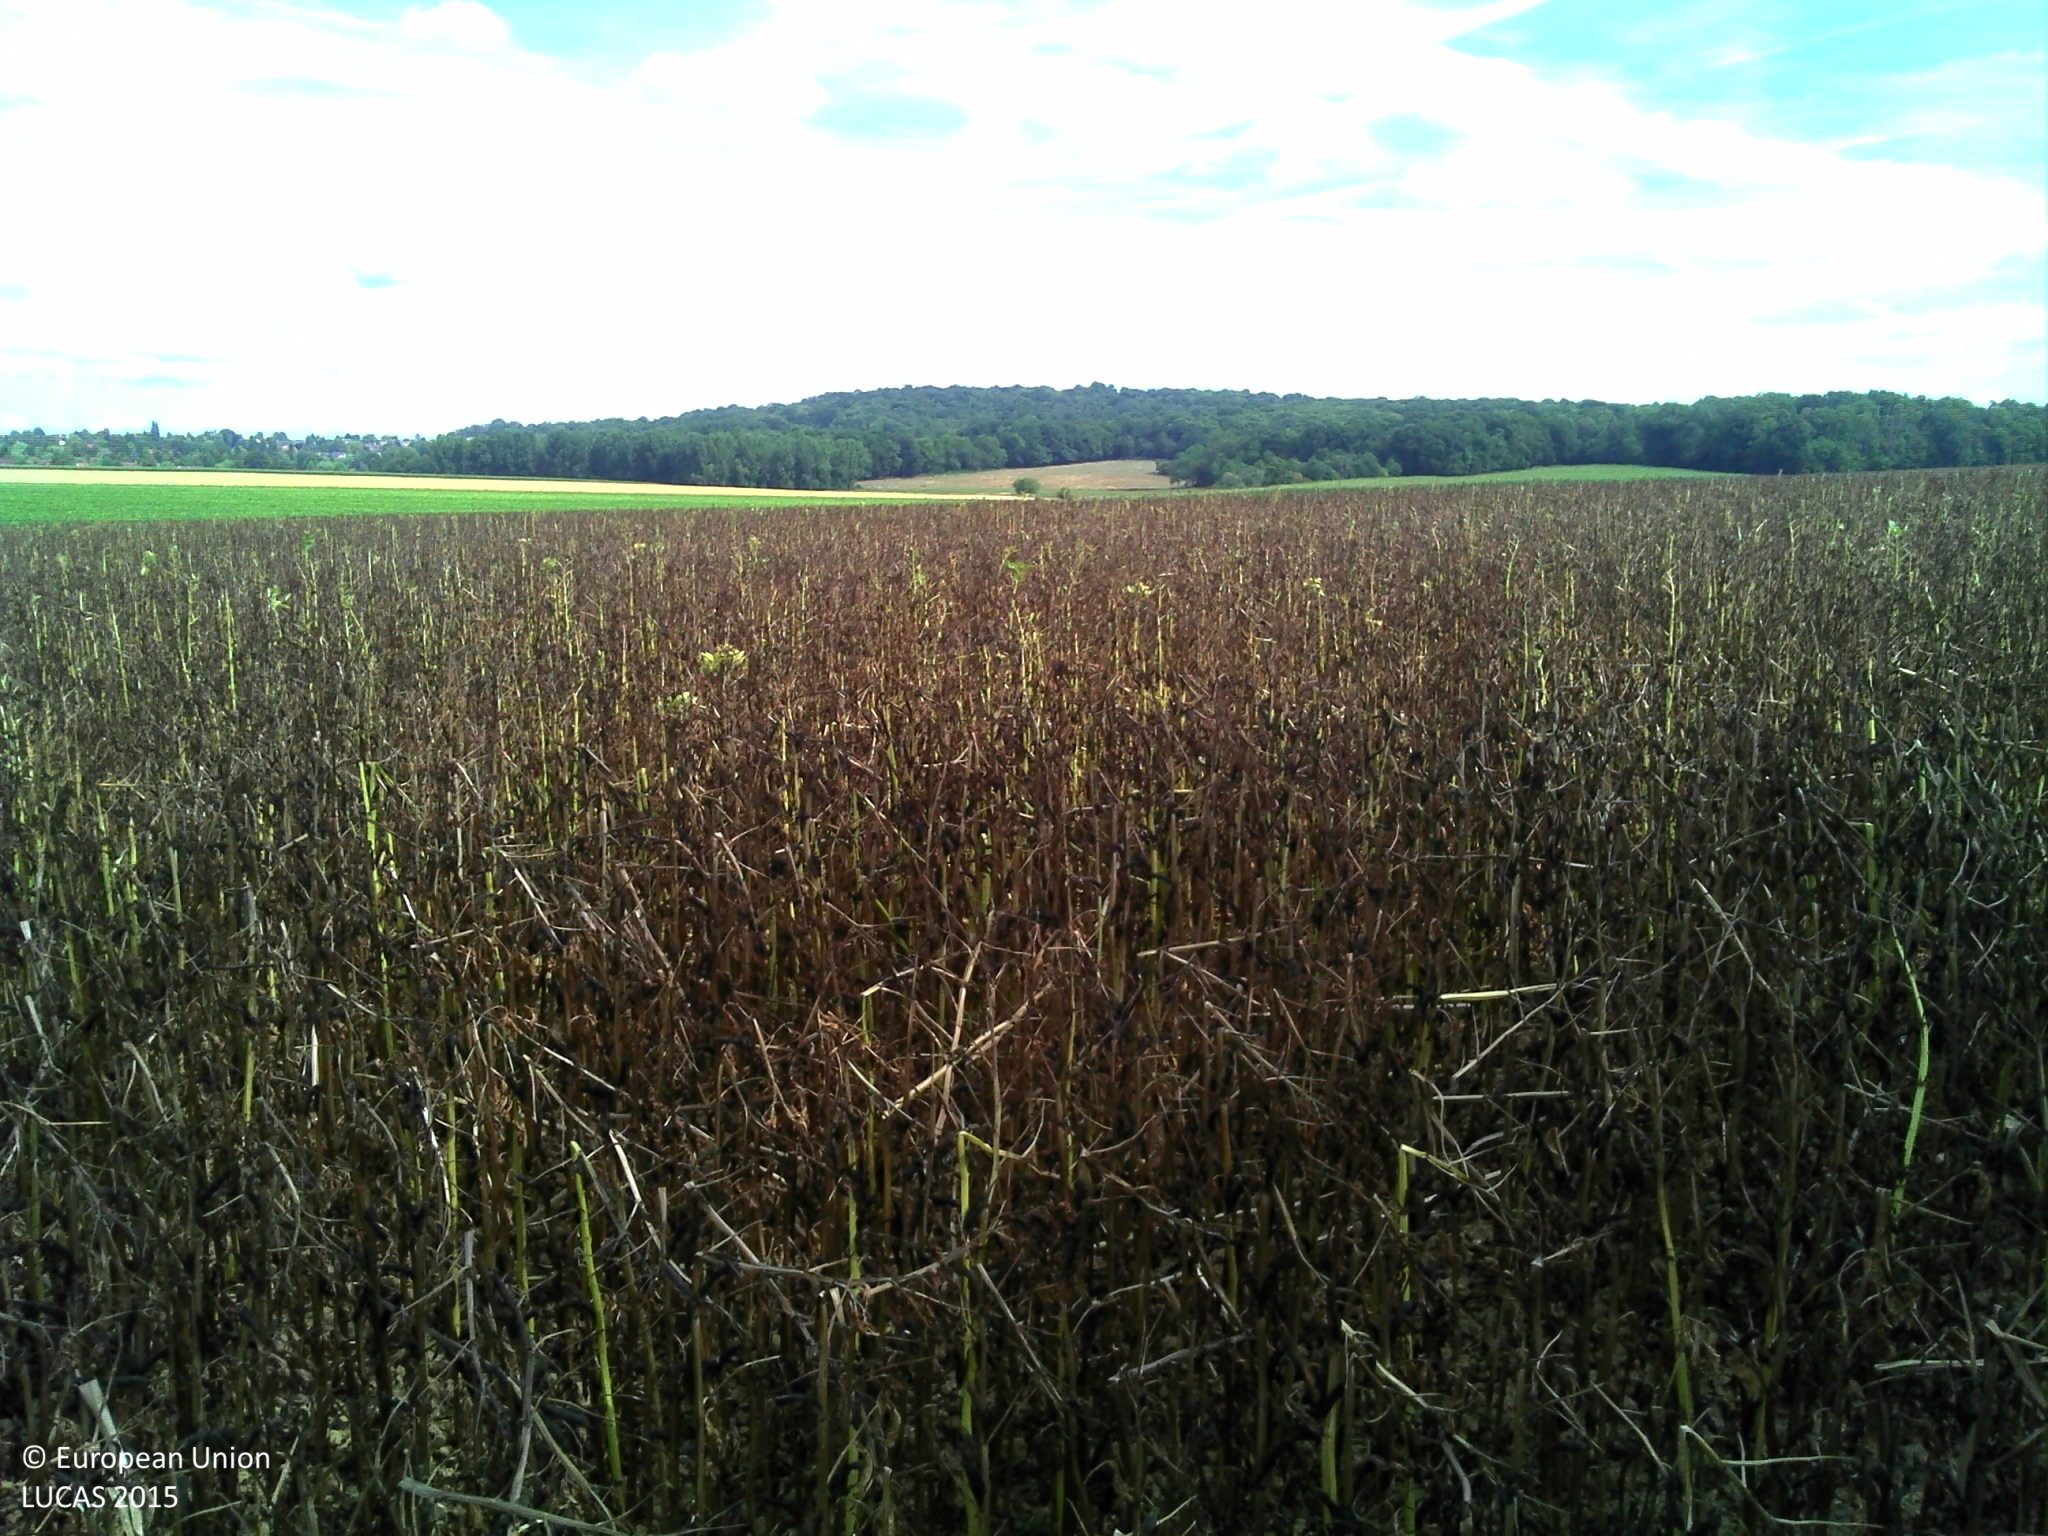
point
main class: Cropland
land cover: Other non-permanent industrial crops
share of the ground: > 75 %
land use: Agriculture (excluding fallow land and kitchen gardens)
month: July
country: FR
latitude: 49.0756
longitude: 2.5828
